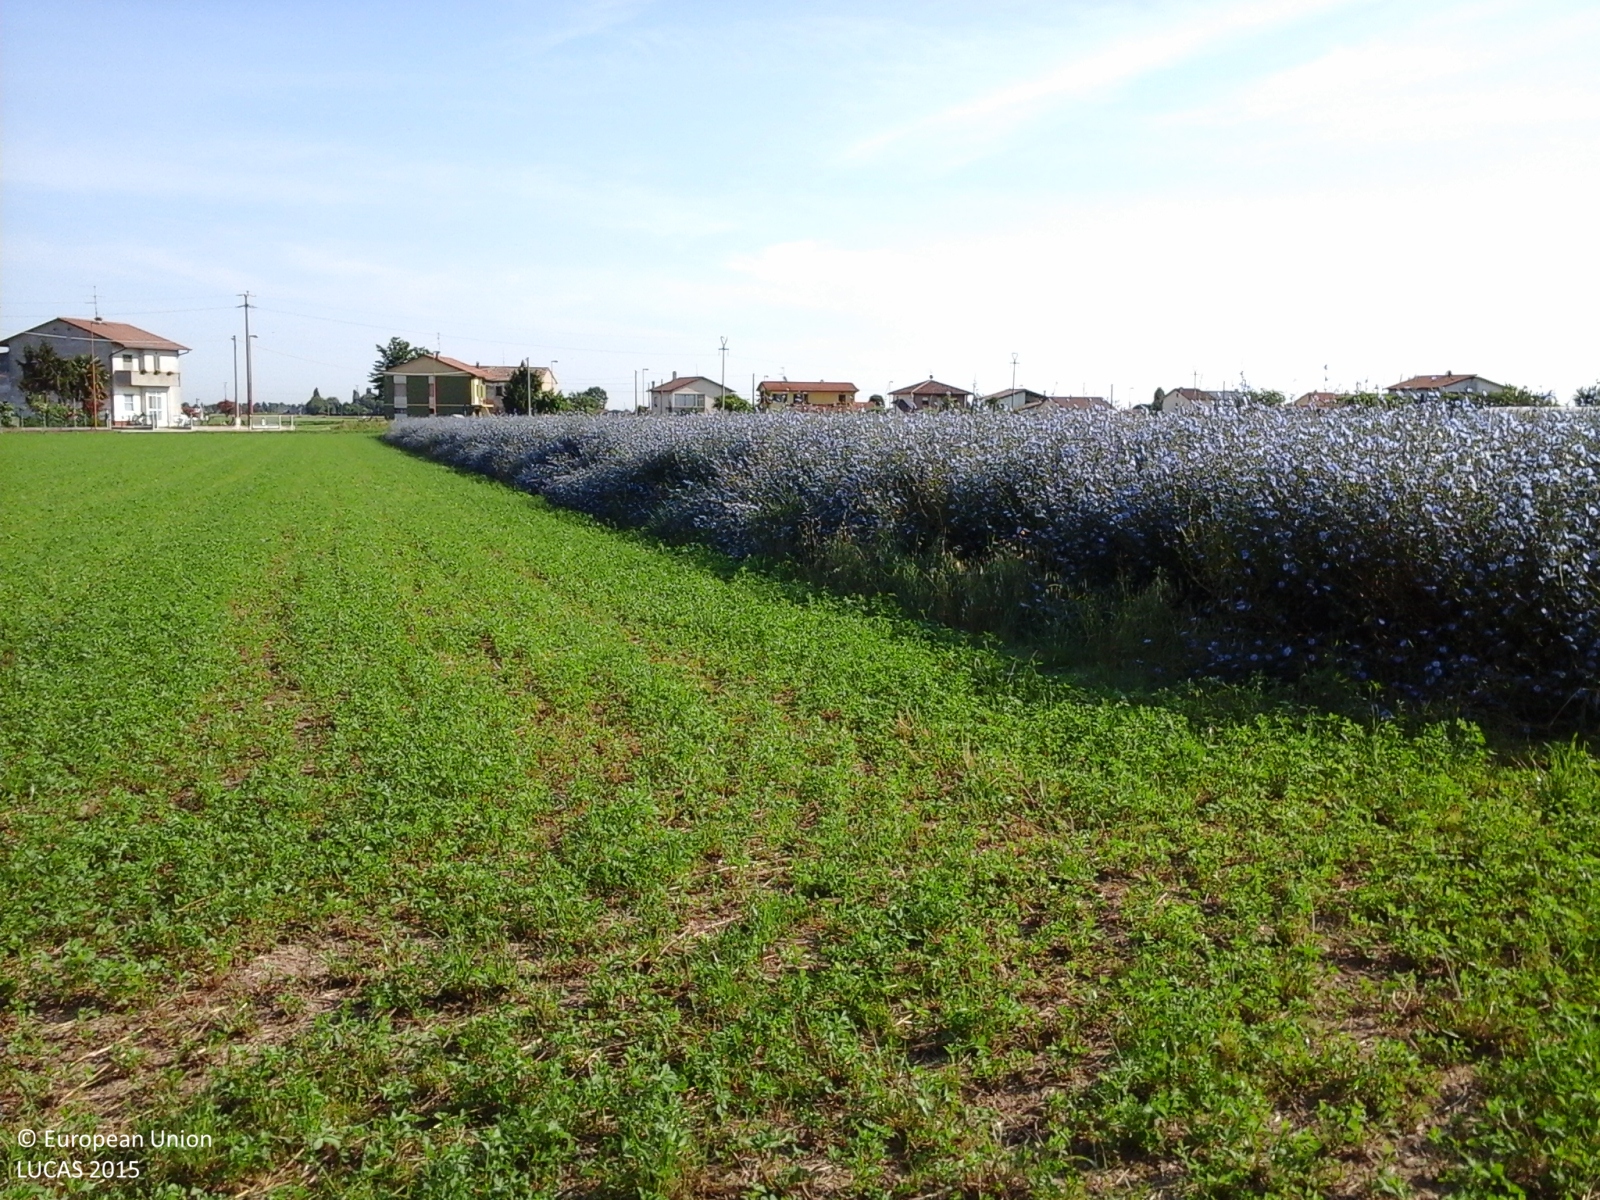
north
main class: Cropland
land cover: Maize
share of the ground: > 75 %
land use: Agriculture (excluding fallow land and kitchen gardens)
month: June
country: IT
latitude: 44.2177
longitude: 12.2605
